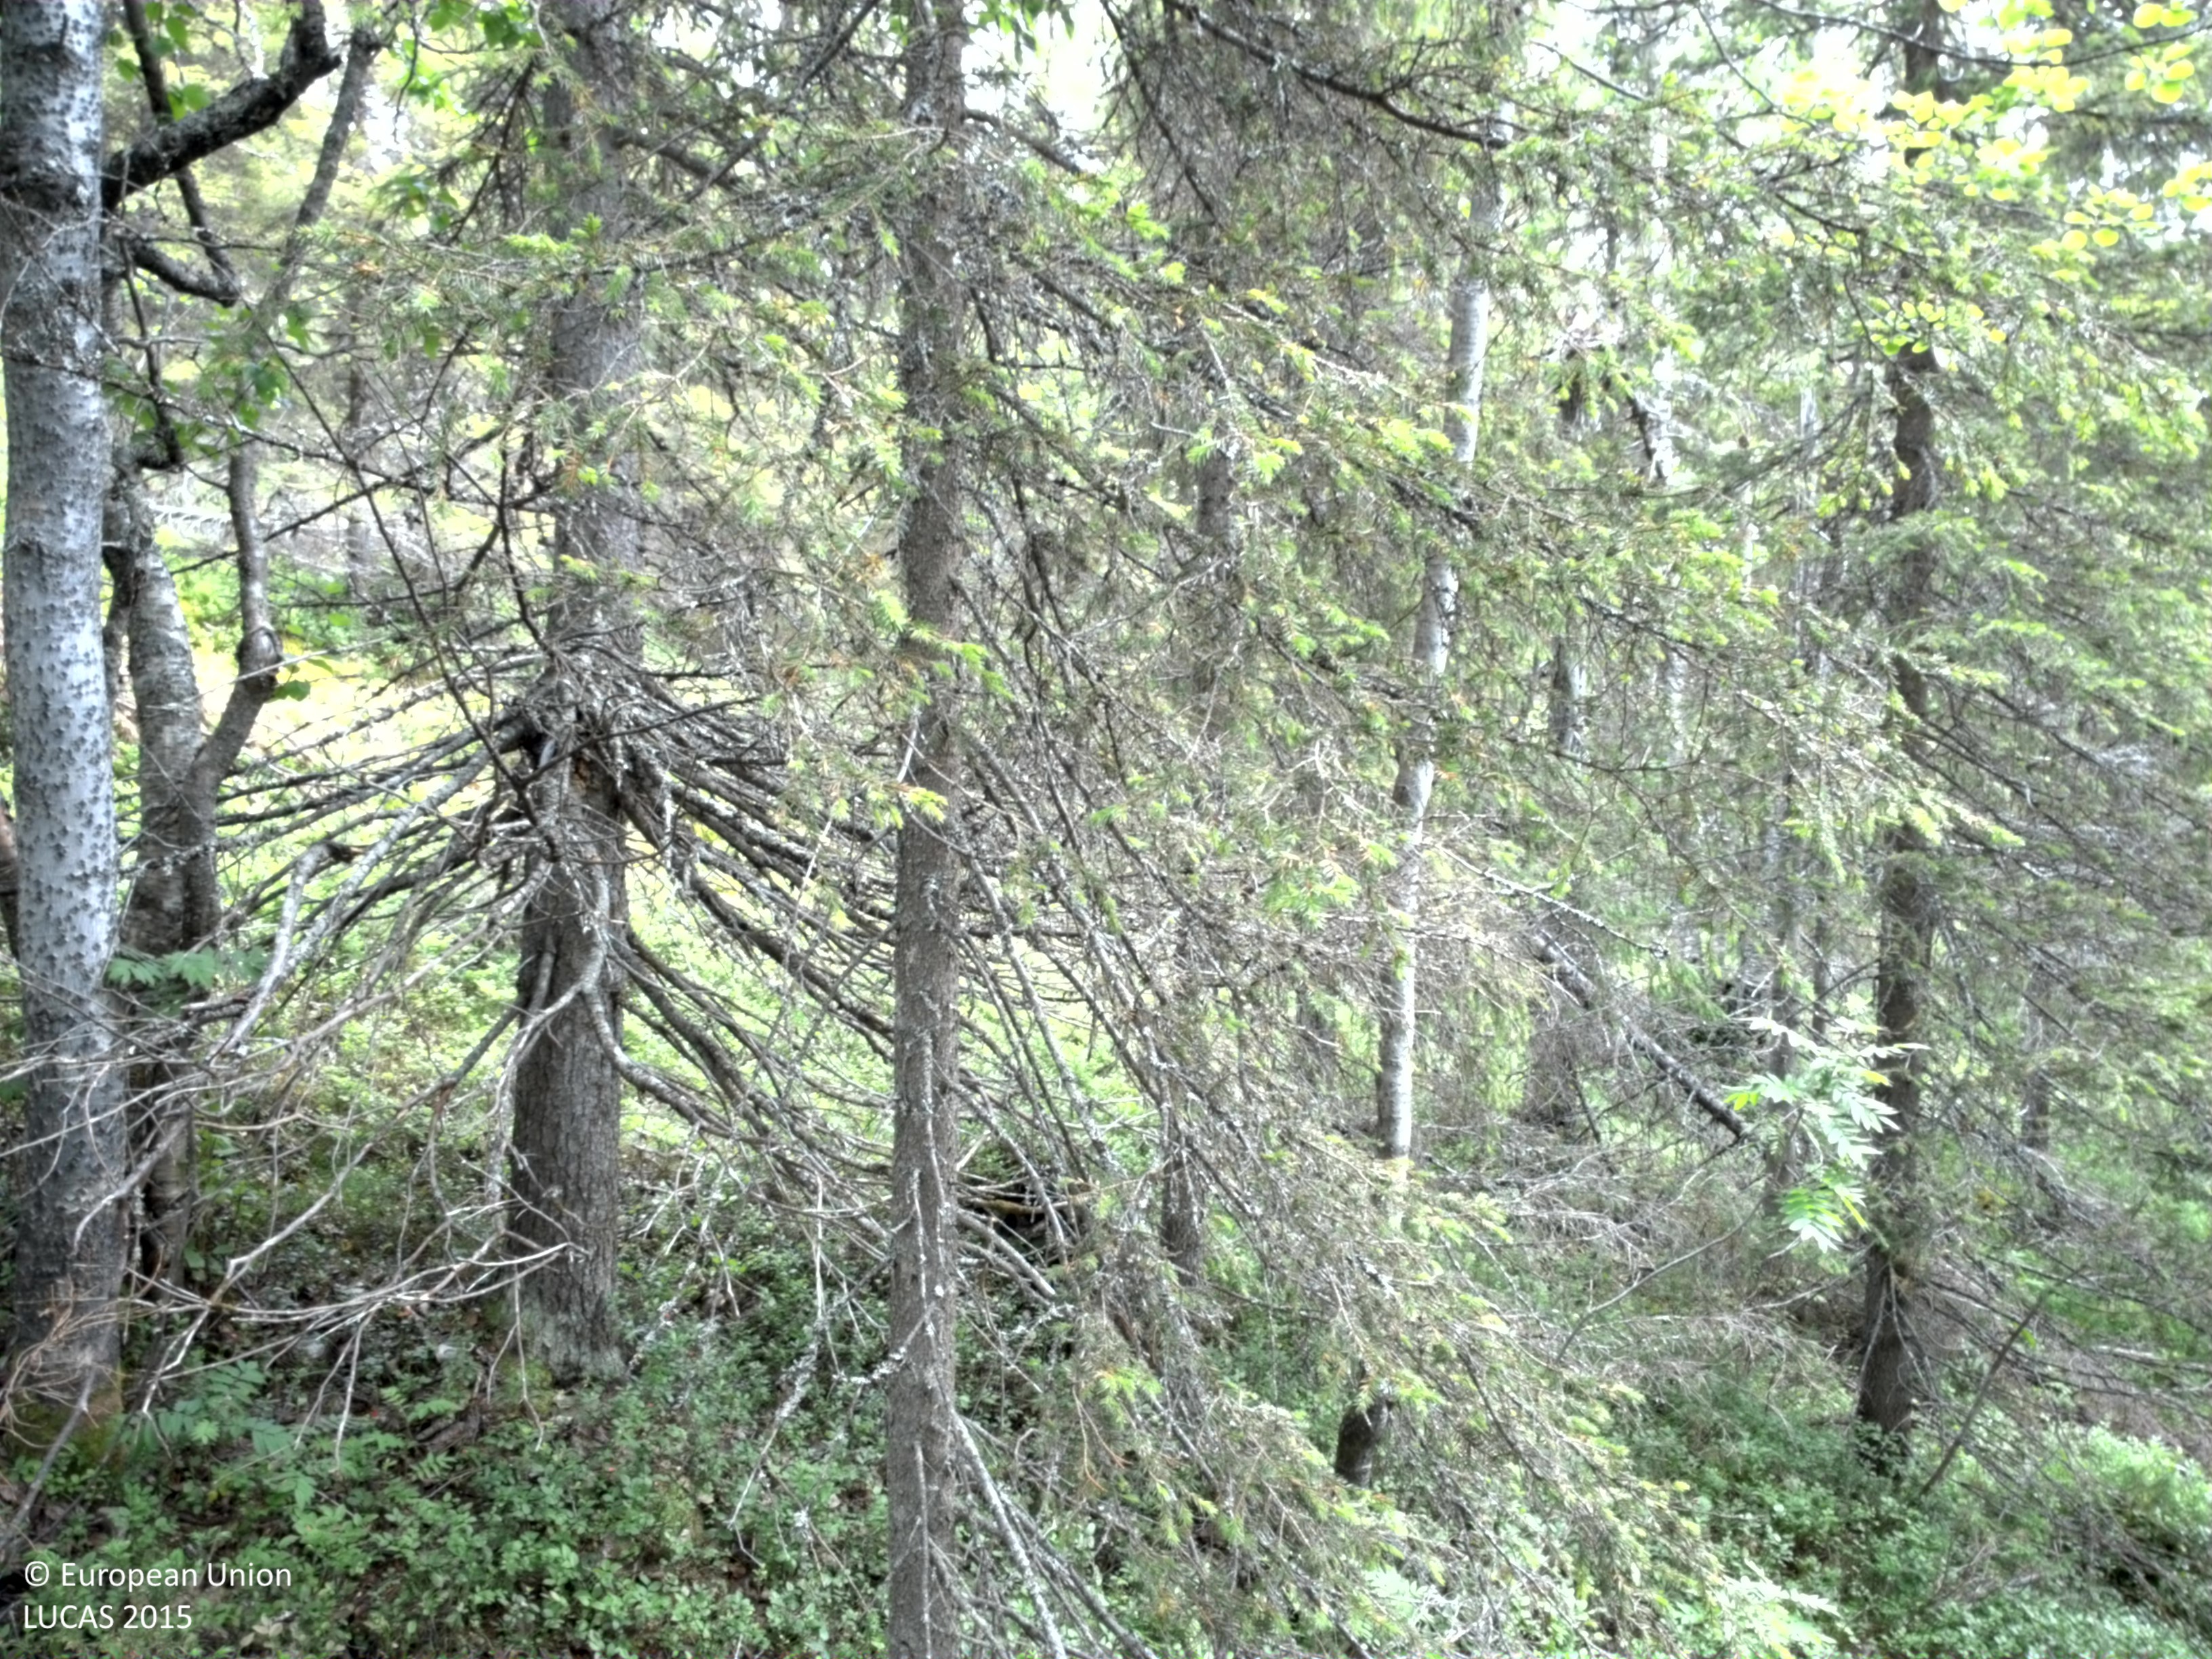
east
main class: Woodland
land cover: Spruce dominated coniferous woodland
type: hemiboreal forest and nemoral coniferous forest and mixed broadleaved-coniferous forest
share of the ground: 25 - 50 %
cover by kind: shrubs 65 %, coniferous forest trees 35 %
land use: Forestry
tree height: > 5 m
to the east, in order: Spruce dominated coniferous woodland; Ditches and canals; Paved roads, cycling and walking lanes
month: August
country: SE
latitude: 66.5345
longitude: 20.7822
